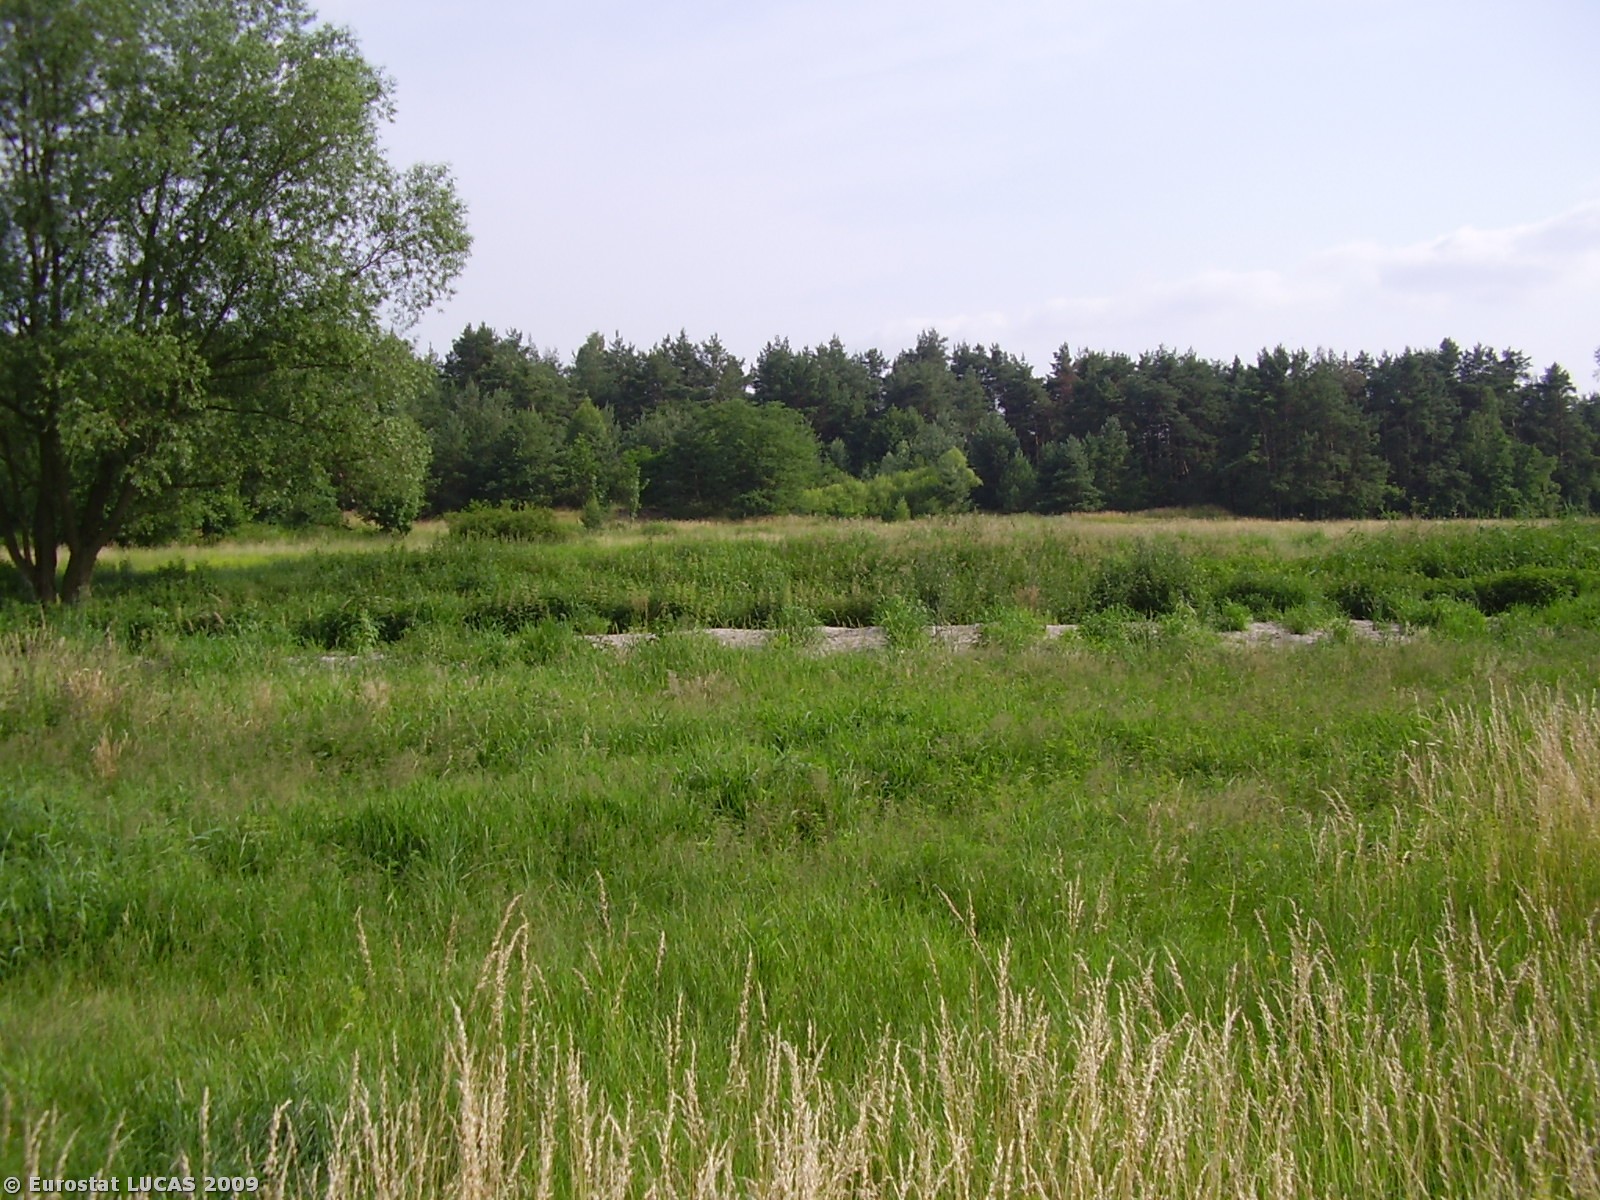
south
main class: Grassland
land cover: Grassland with sparse tree/shrub cover
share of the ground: > 75 %
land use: Unused
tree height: > 5 m
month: June
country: PL
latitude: 51.7129
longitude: 16.1575
